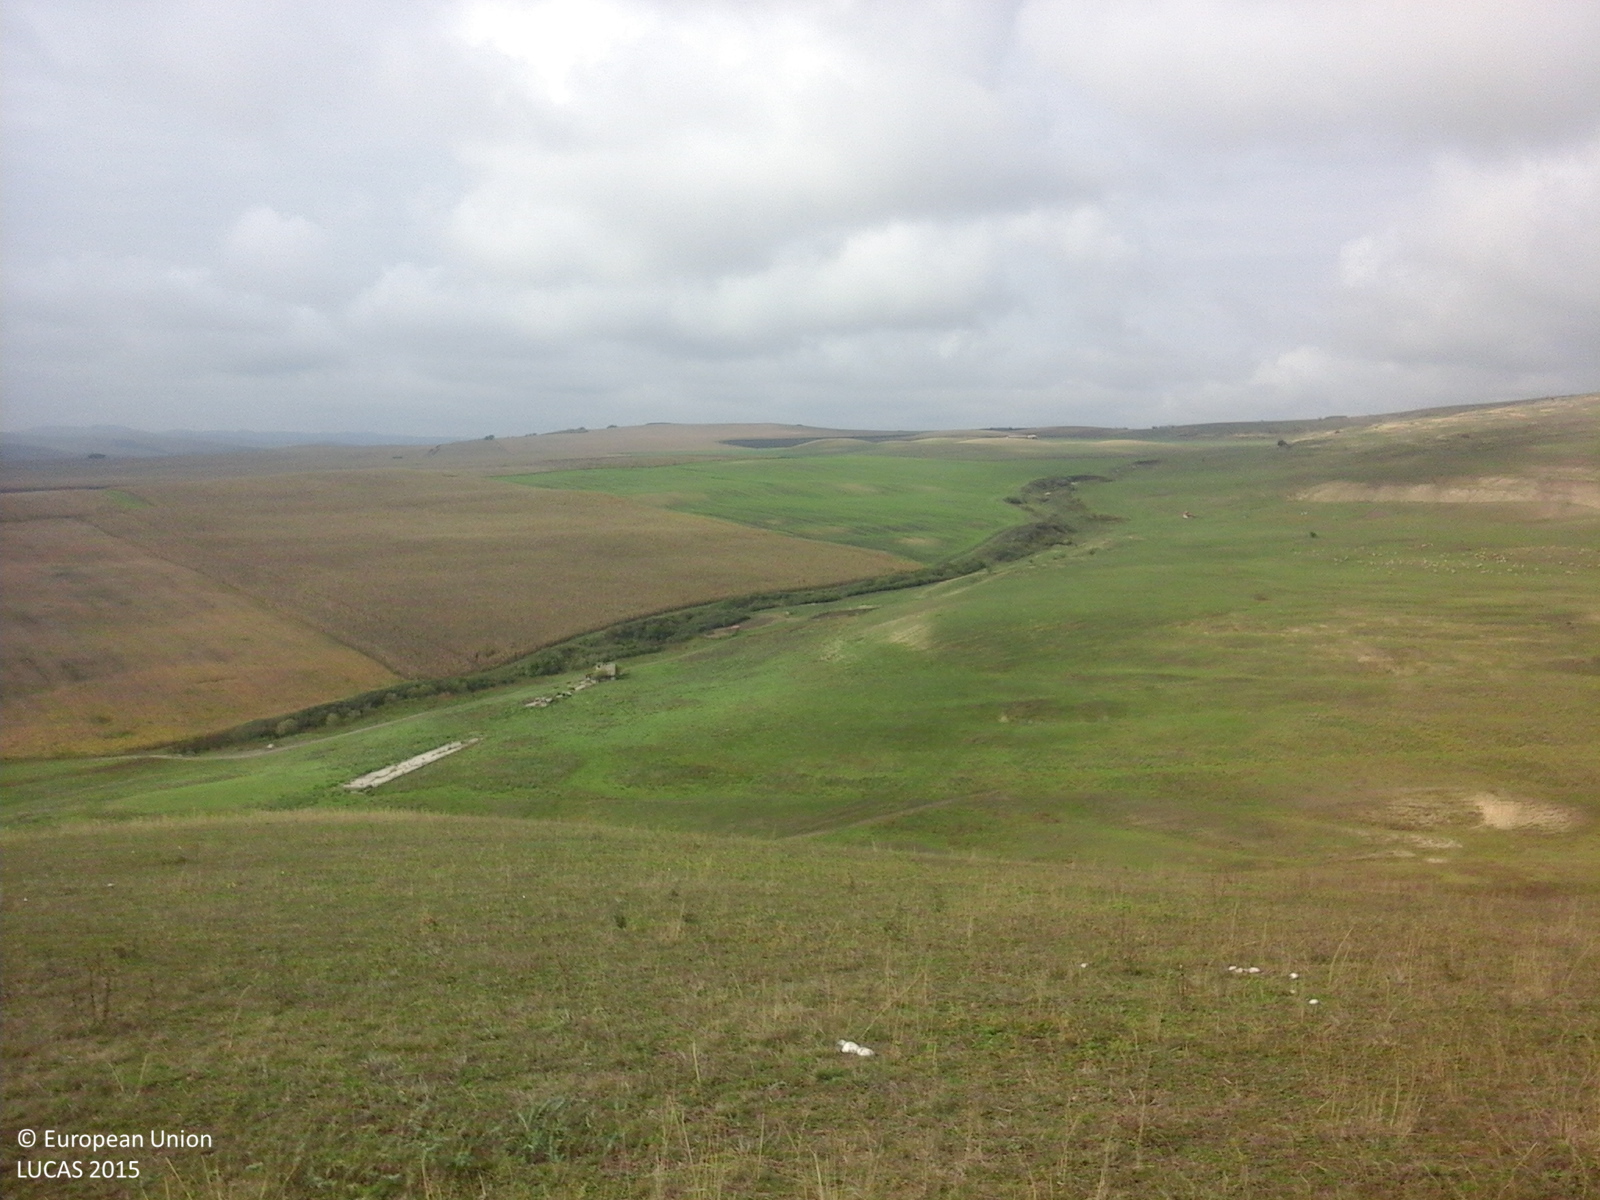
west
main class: Grassland
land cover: Grassland without tree/shrub cover
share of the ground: > 75 %
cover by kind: herbaceous plants 100 %
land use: Agriculture (excluding fallow land and kitchen gardens)
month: October
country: RO
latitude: 46.2657
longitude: 23.9971
